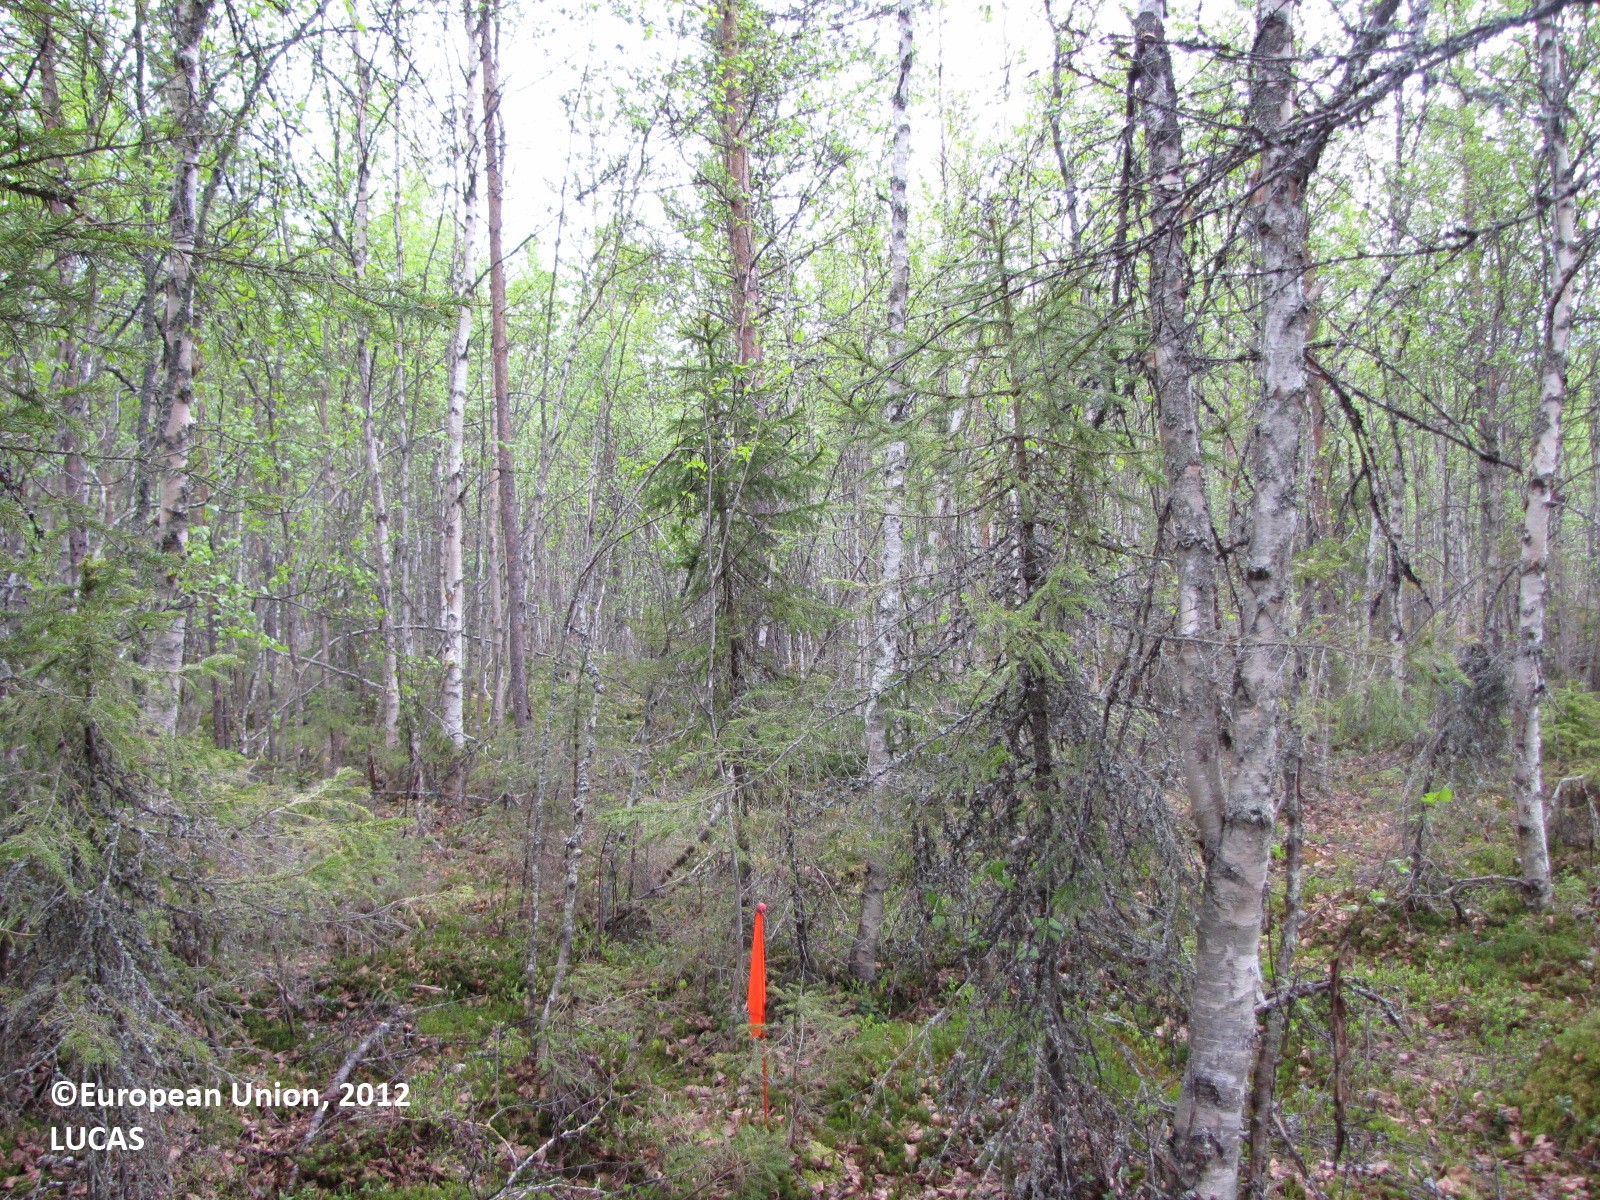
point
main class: Woodland
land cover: Other mixed woodland
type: boreal forest
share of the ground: 50 - 75 %
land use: Forestry
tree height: > 5 m
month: June
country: FI
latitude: 65.9015
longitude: 24.7405
